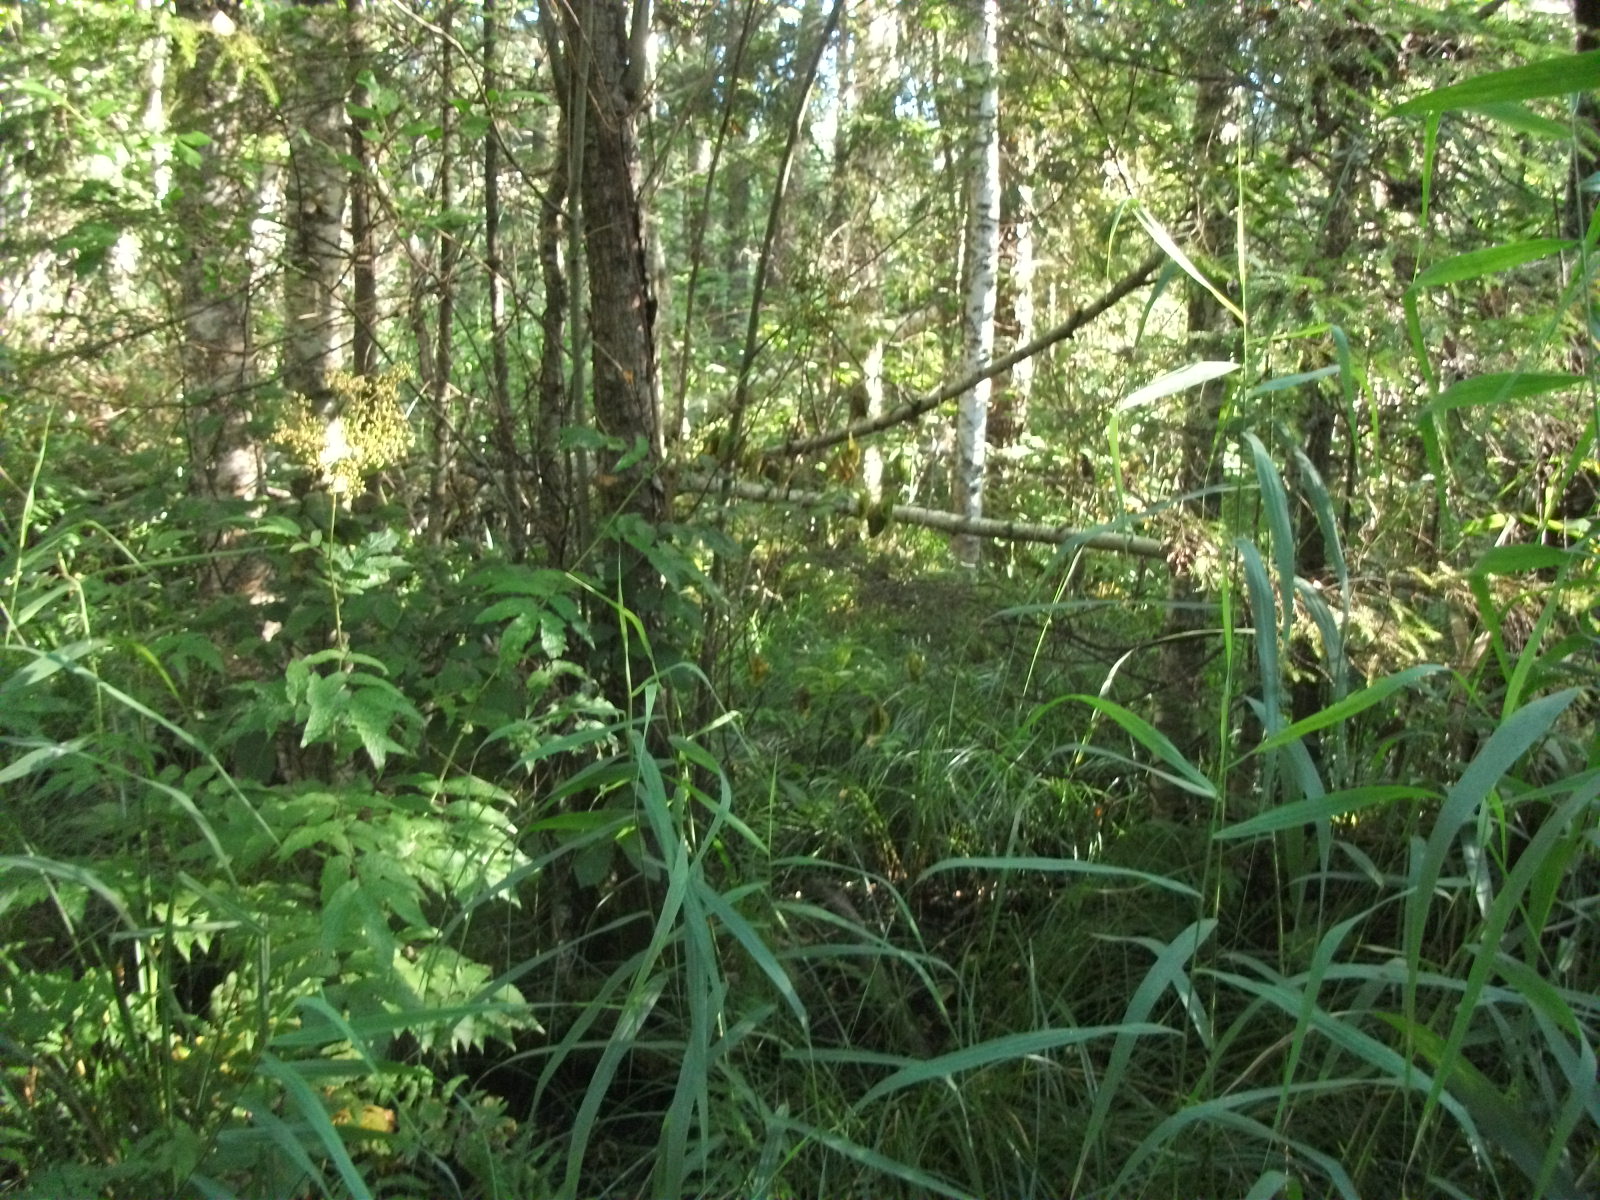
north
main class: Woodland
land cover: Broadleaved woodland
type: mire and swamp forests
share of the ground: > 75 %
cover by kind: broadleaved forest trees 80 %, shrubs 10 %, herbaceous plants 10 %
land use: Forestry
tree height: > 5 m
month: August
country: LV
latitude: 56.7343
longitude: 26.3076
